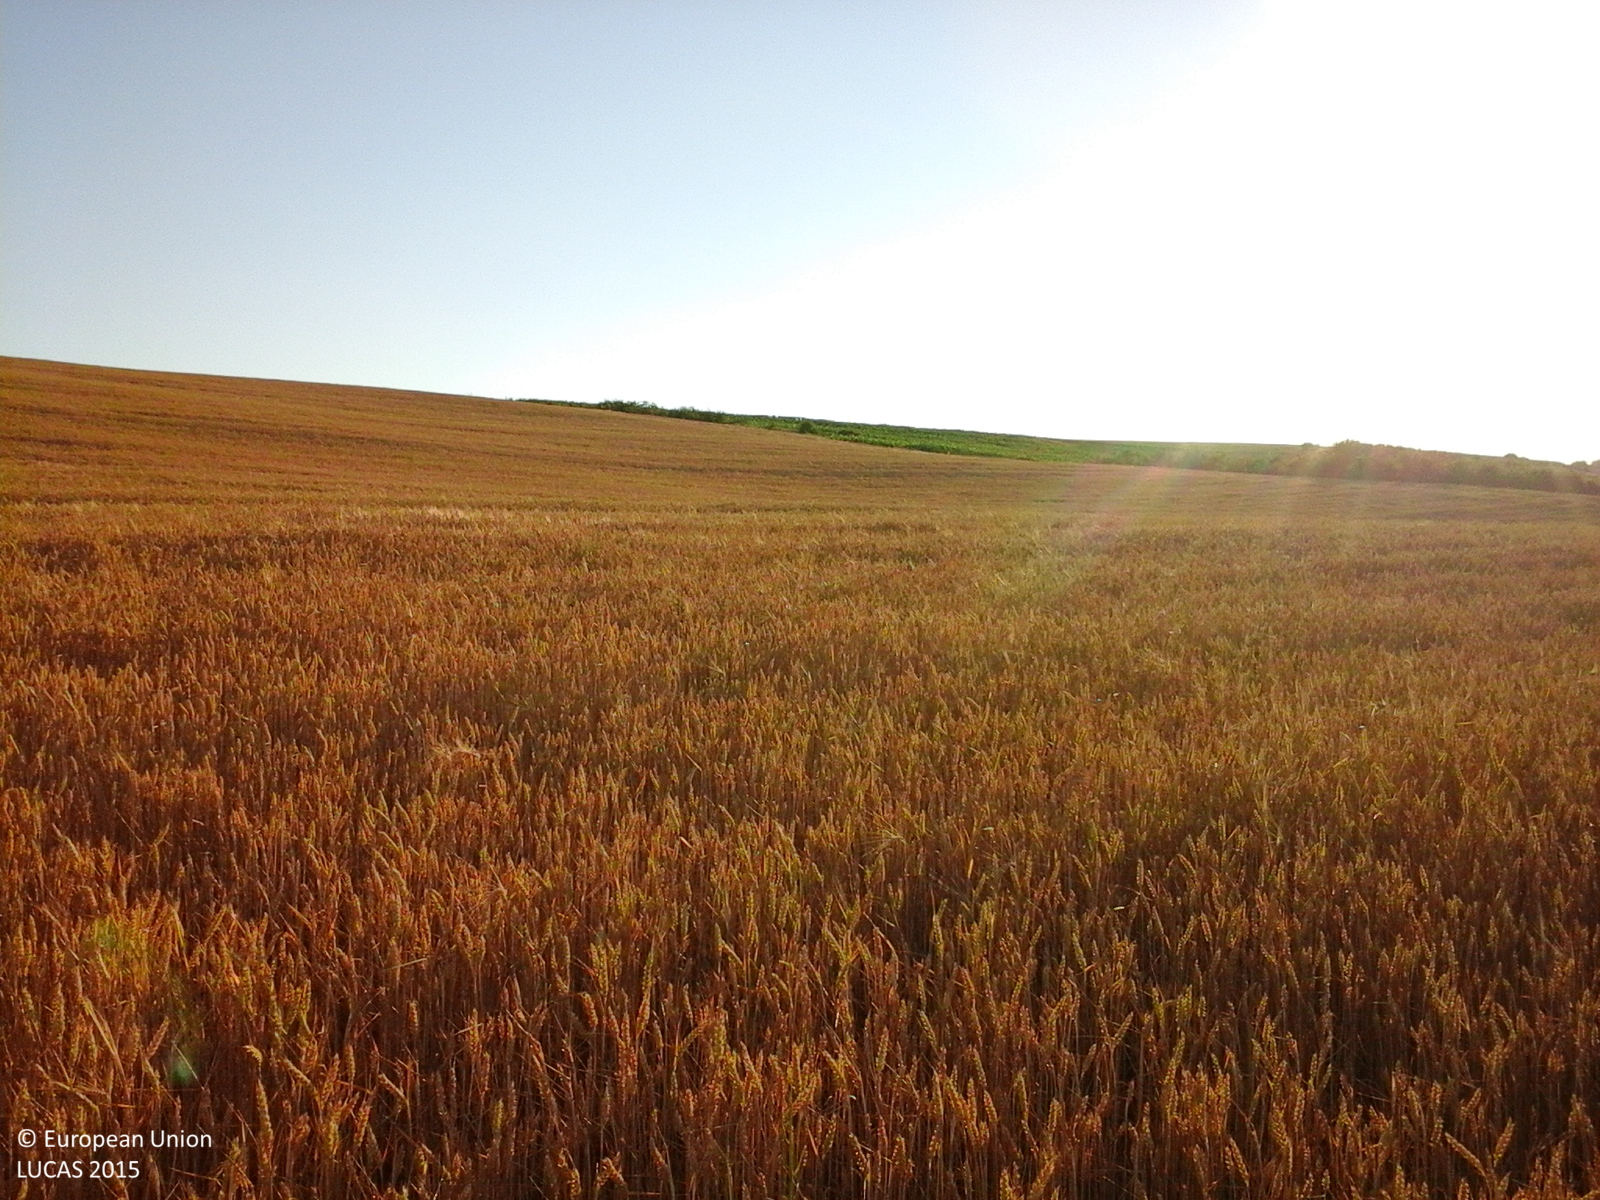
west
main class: Cropland
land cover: Common wheat
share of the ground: > 75 %
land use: Agriculture (excluding fallow land and kitchen gardens)
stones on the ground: < 10 %
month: June
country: RO
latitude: 46.9664
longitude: 27.9911
